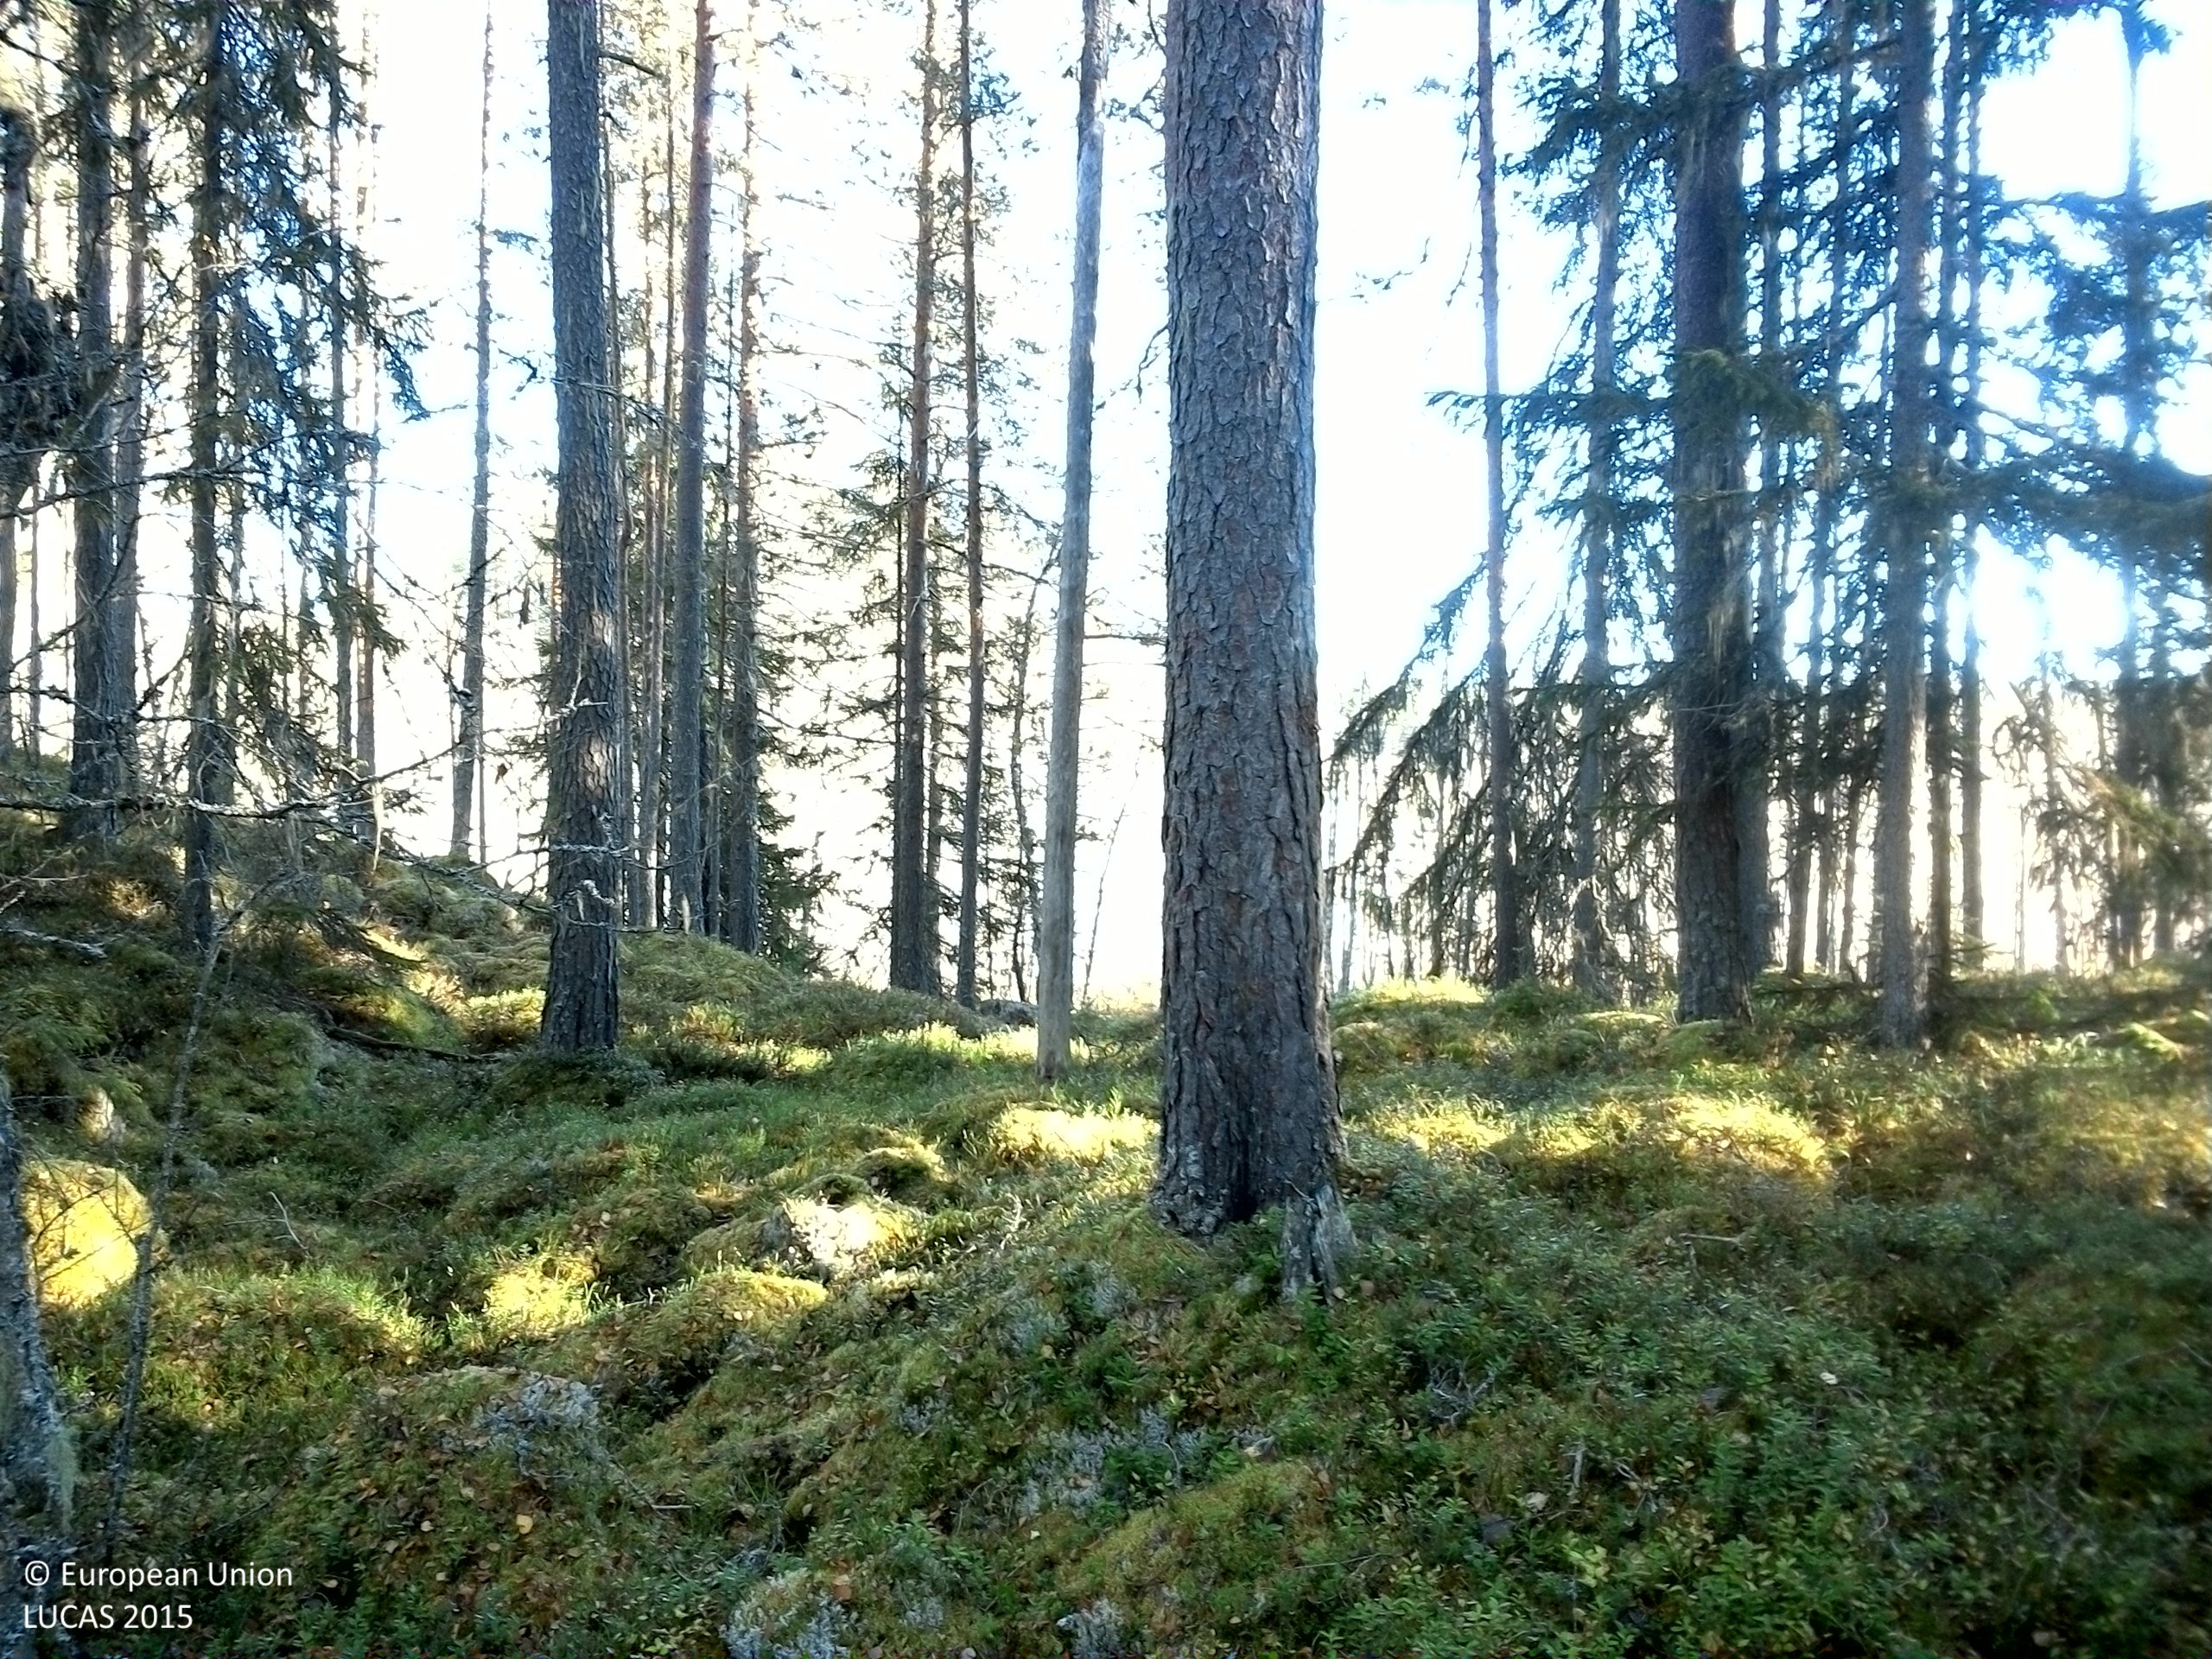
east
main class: Woodland
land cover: Pine dominated coniferous woodland
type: boreal forest
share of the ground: > 75 %
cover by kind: coniferous forest trees 75 %, shrubs 15 %, lichens and mosses 10 %
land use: Forestry
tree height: > 5 m
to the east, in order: Pine dominated coniferous woodland; Other mixed woodland; Pine dominated mixed woodland; Pine dominated coniferous woodland; Other mixed woodland; Pine dominated coniferous woodland
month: October
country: SE
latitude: 61.1427
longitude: 14.3143
